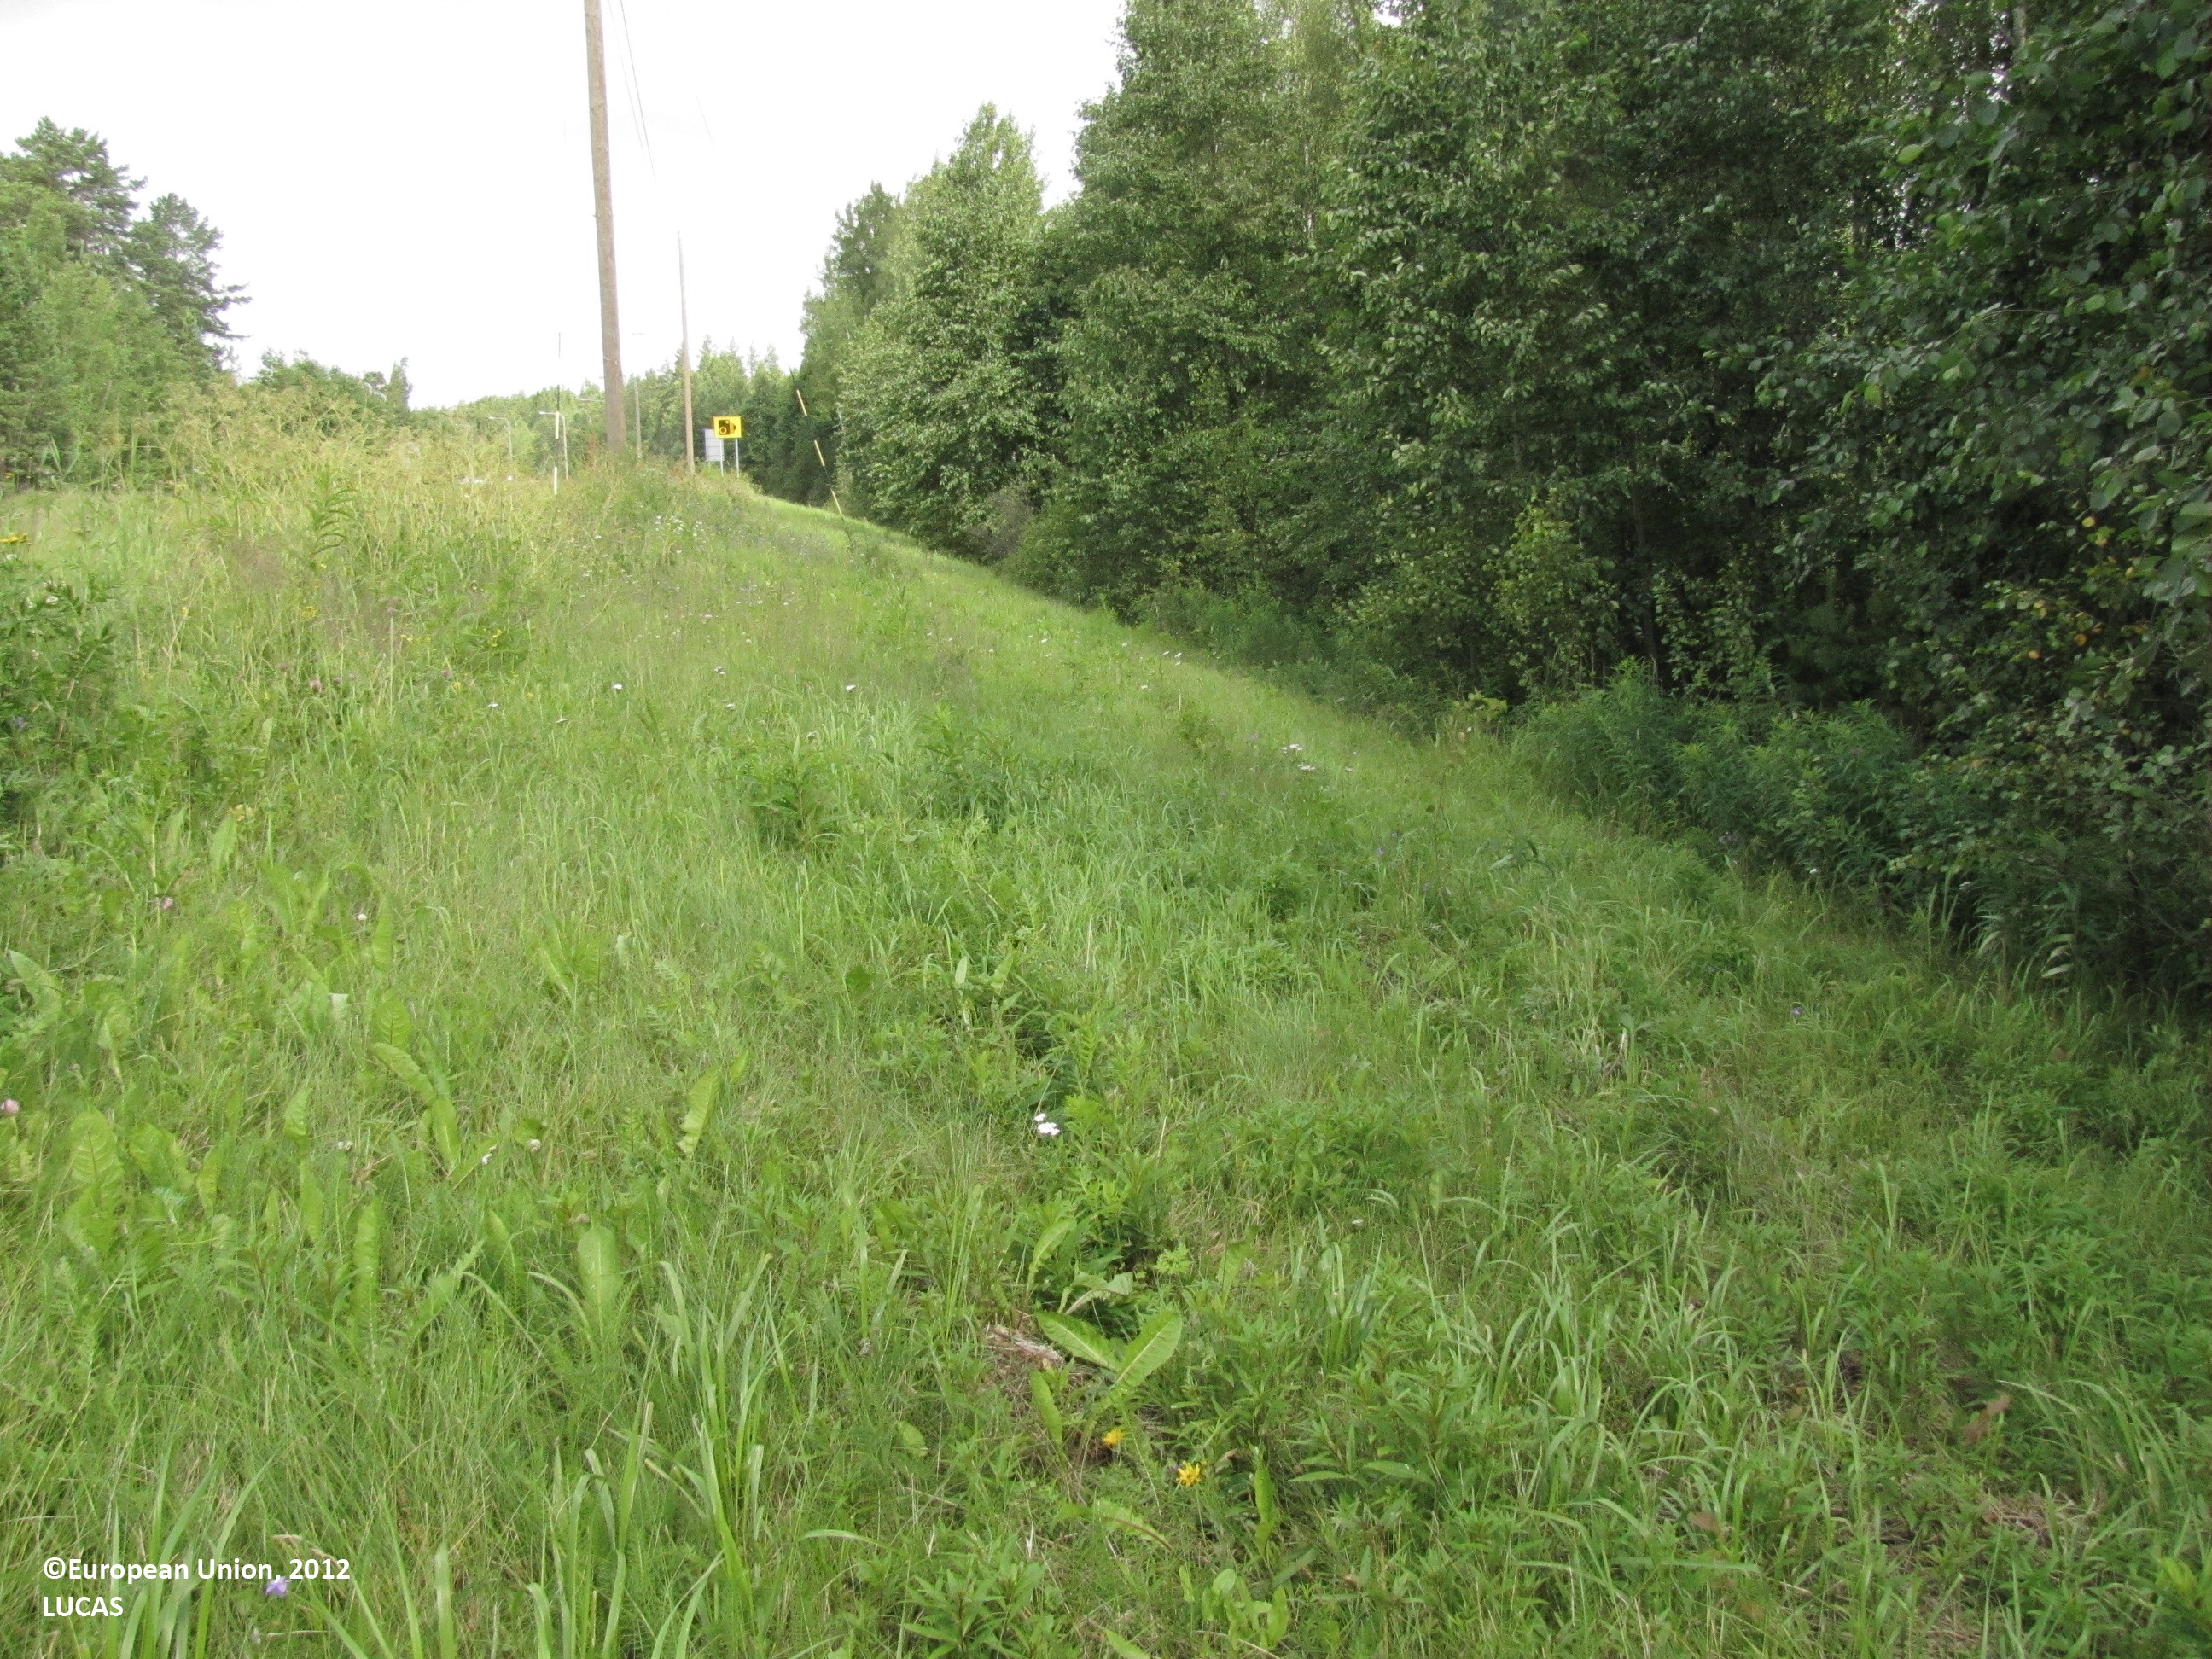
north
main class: Grassland
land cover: Grassland without tree/shrub cover
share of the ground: > 75 %
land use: Road transport
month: July
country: FI
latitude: 62.2731
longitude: 22.9143
